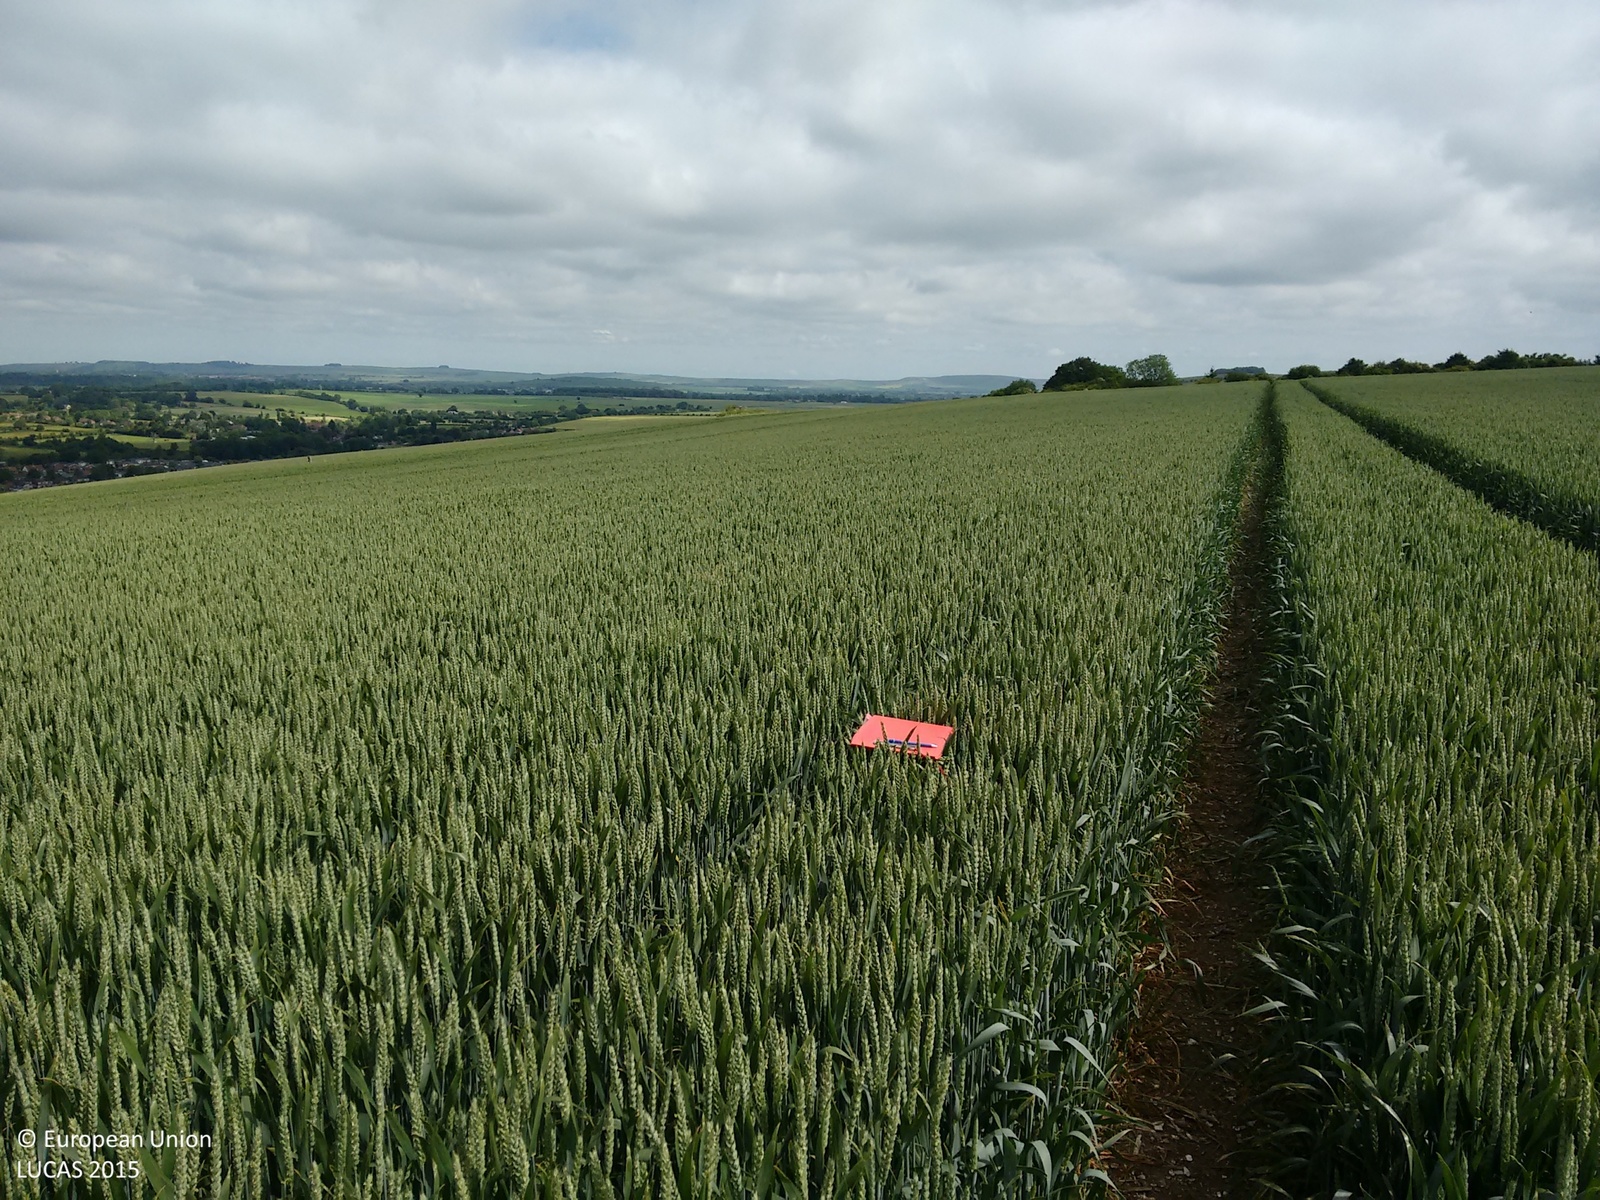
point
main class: Cropland
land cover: Common wheat
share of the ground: > 75 %
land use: Agriculture (excluding fallow land and kitchen gardens)
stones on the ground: 25 - 50 %
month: June
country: GB
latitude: 51.2781
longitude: -1.9711
